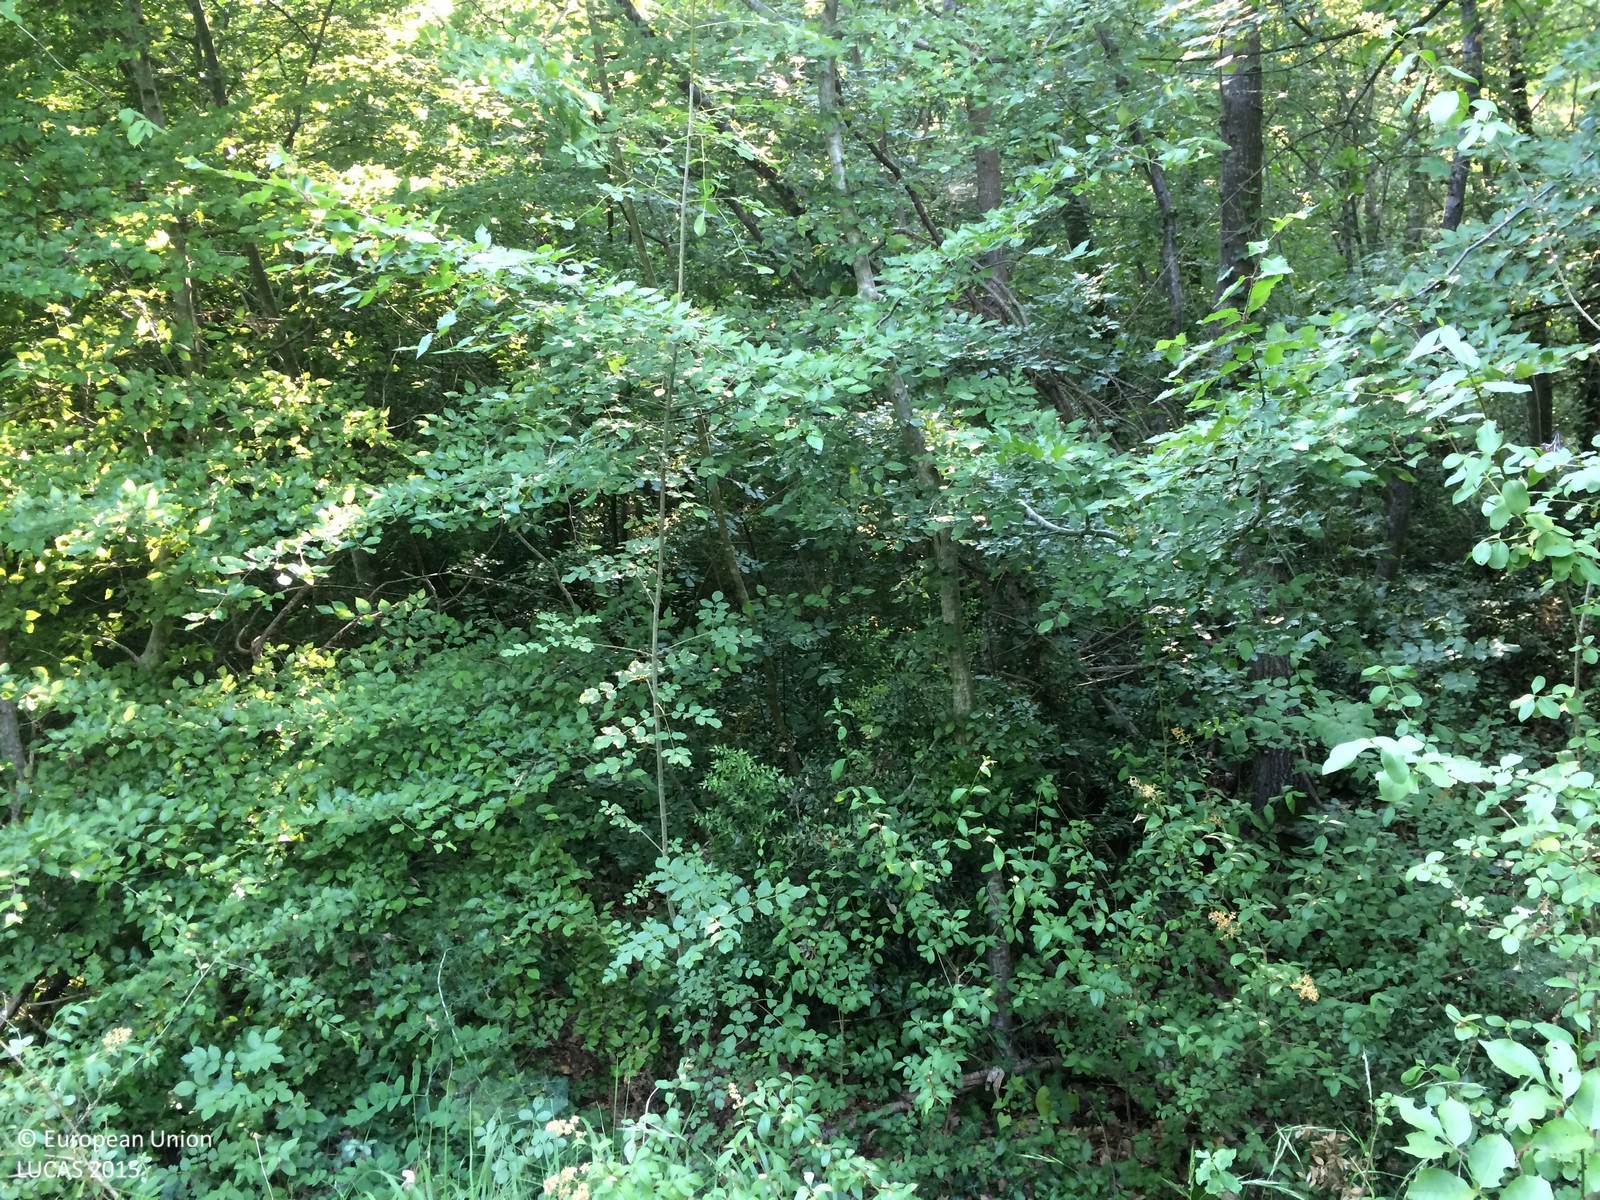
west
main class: Woodland
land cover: Broadleaved woodland
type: mesophytic deciduous forest
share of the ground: > 75 %
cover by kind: broadleaved forest trees 90 %, shrubs 10 %
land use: Semi-natural and natural areas not in use
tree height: > 5 m
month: June
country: HR
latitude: 45.0196
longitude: 13.8395
